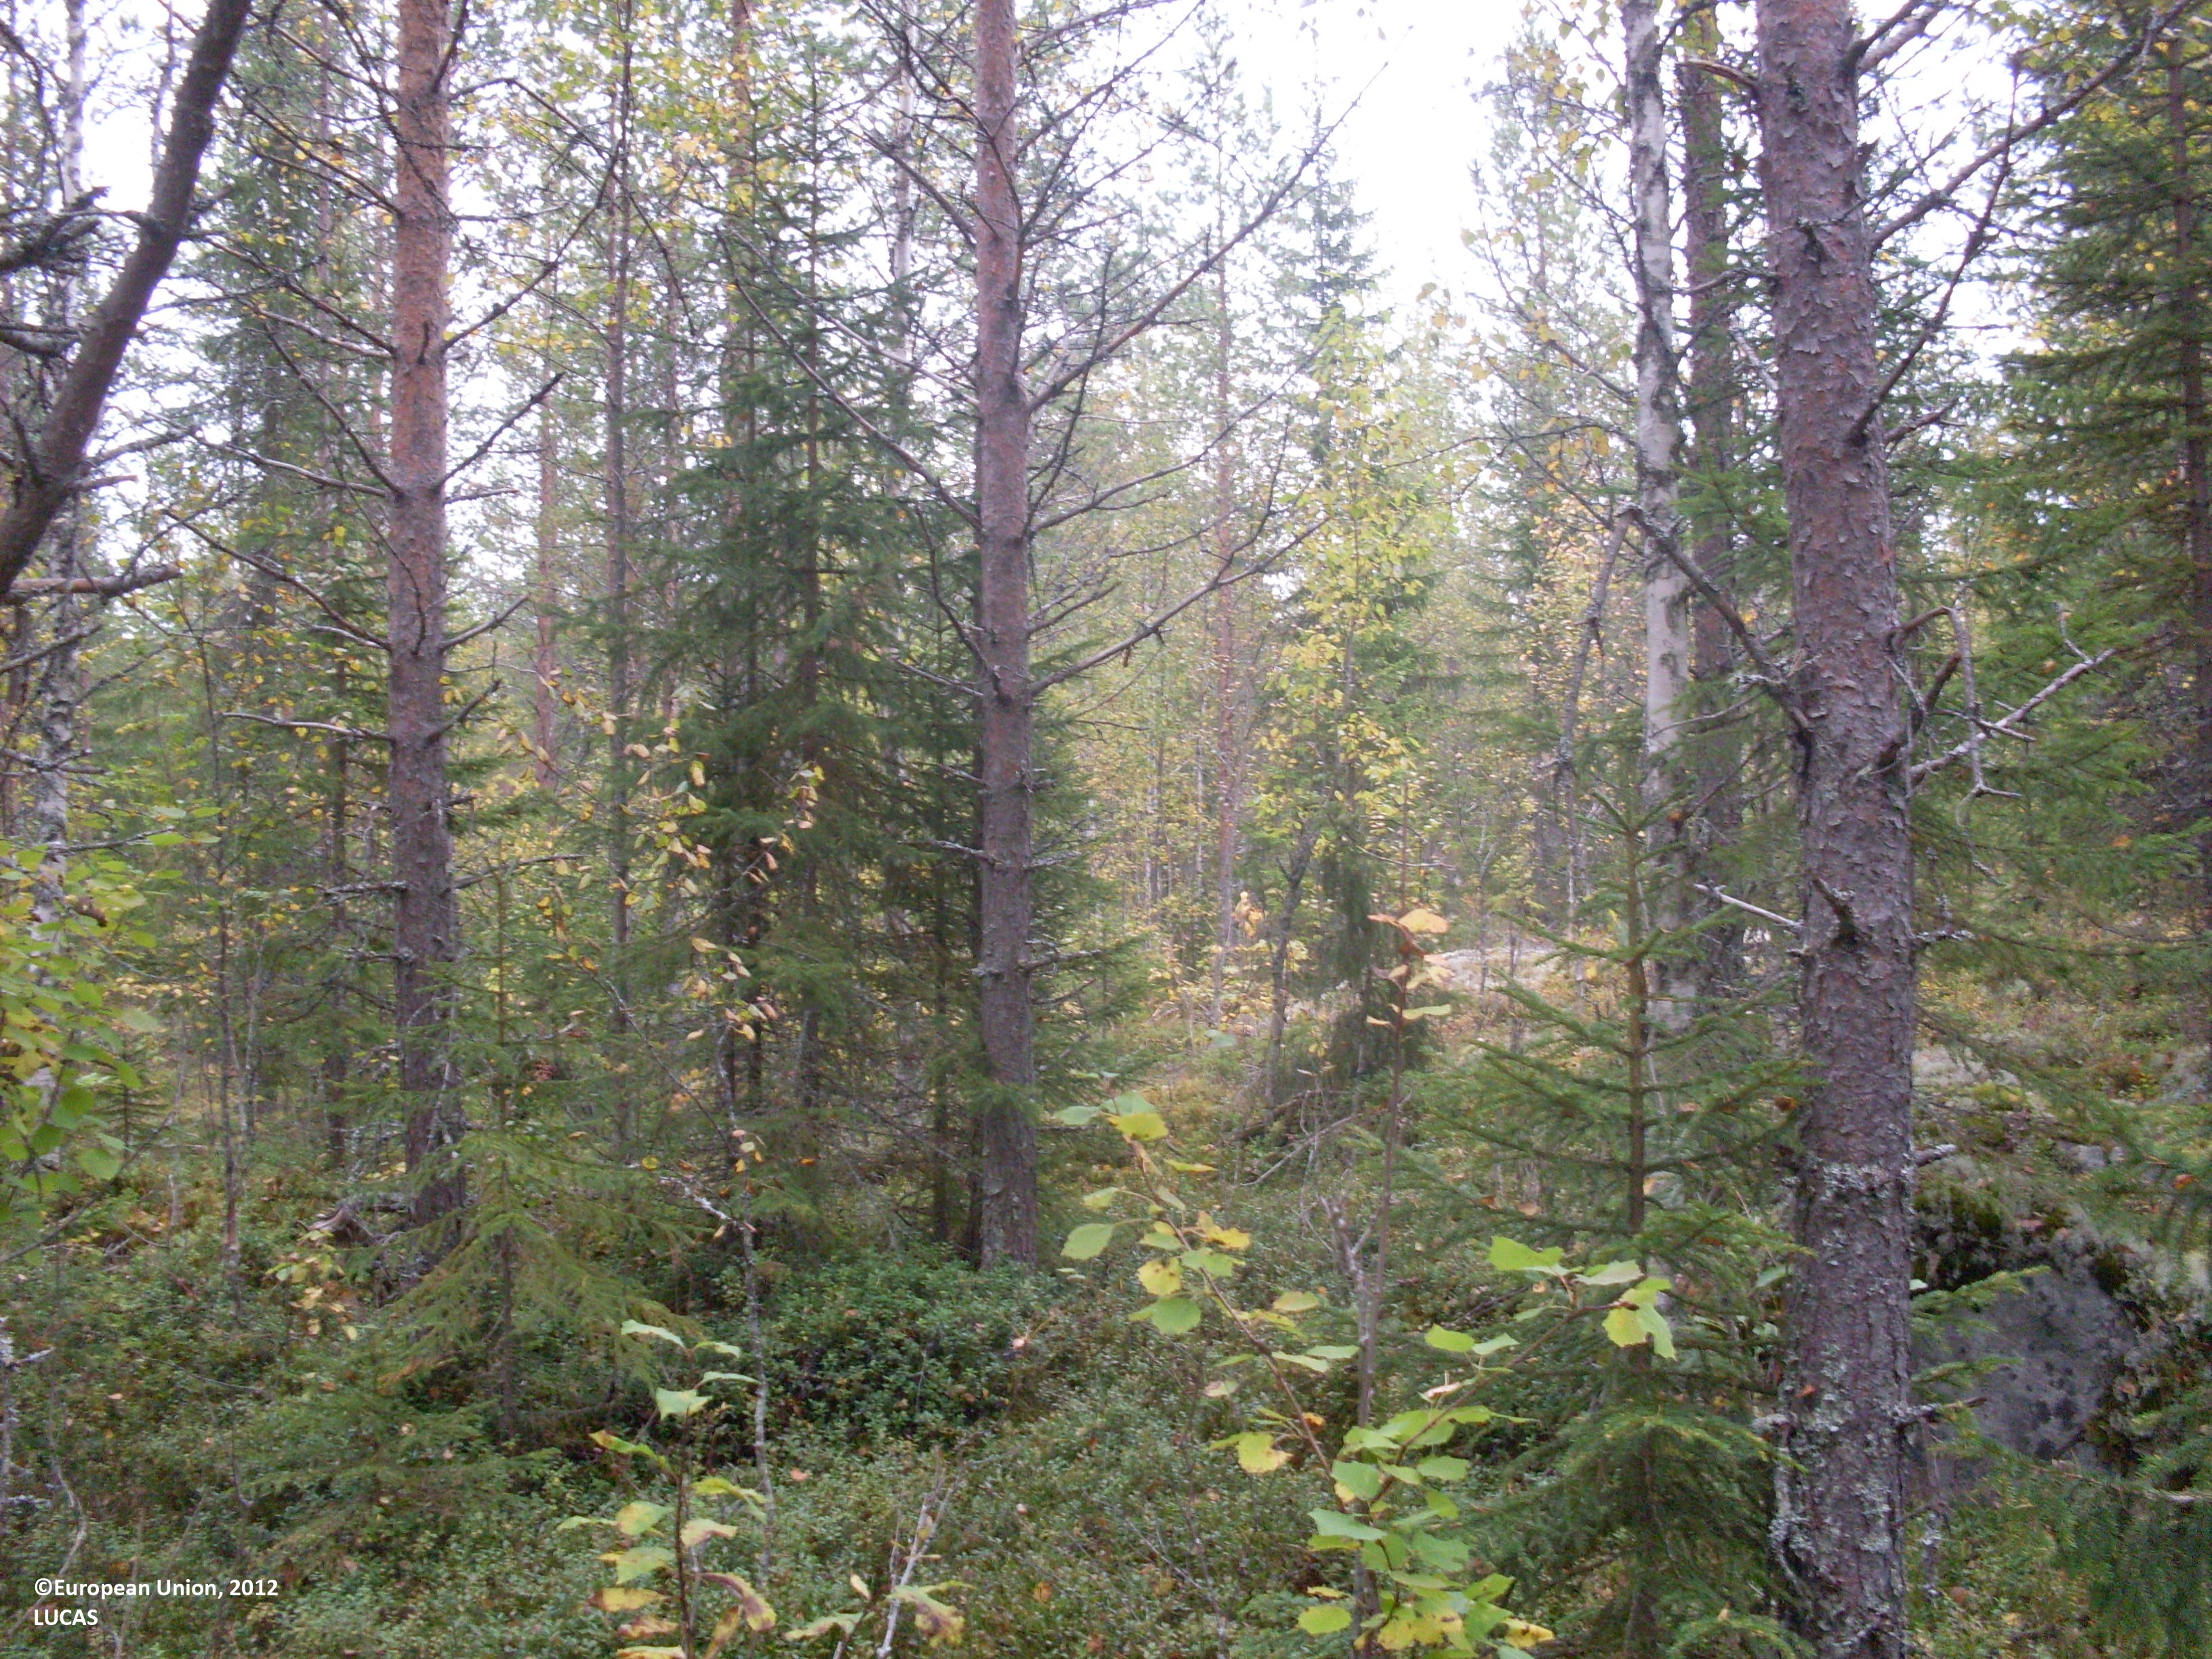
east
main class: Woodland
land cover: Other mixed woodland
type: boreal forest
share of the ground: > 75 %
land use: Forestry
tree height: > 5 m
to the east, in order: Other mixed woodland
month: September
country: FI
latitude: 63.9992
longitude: 29.8841
